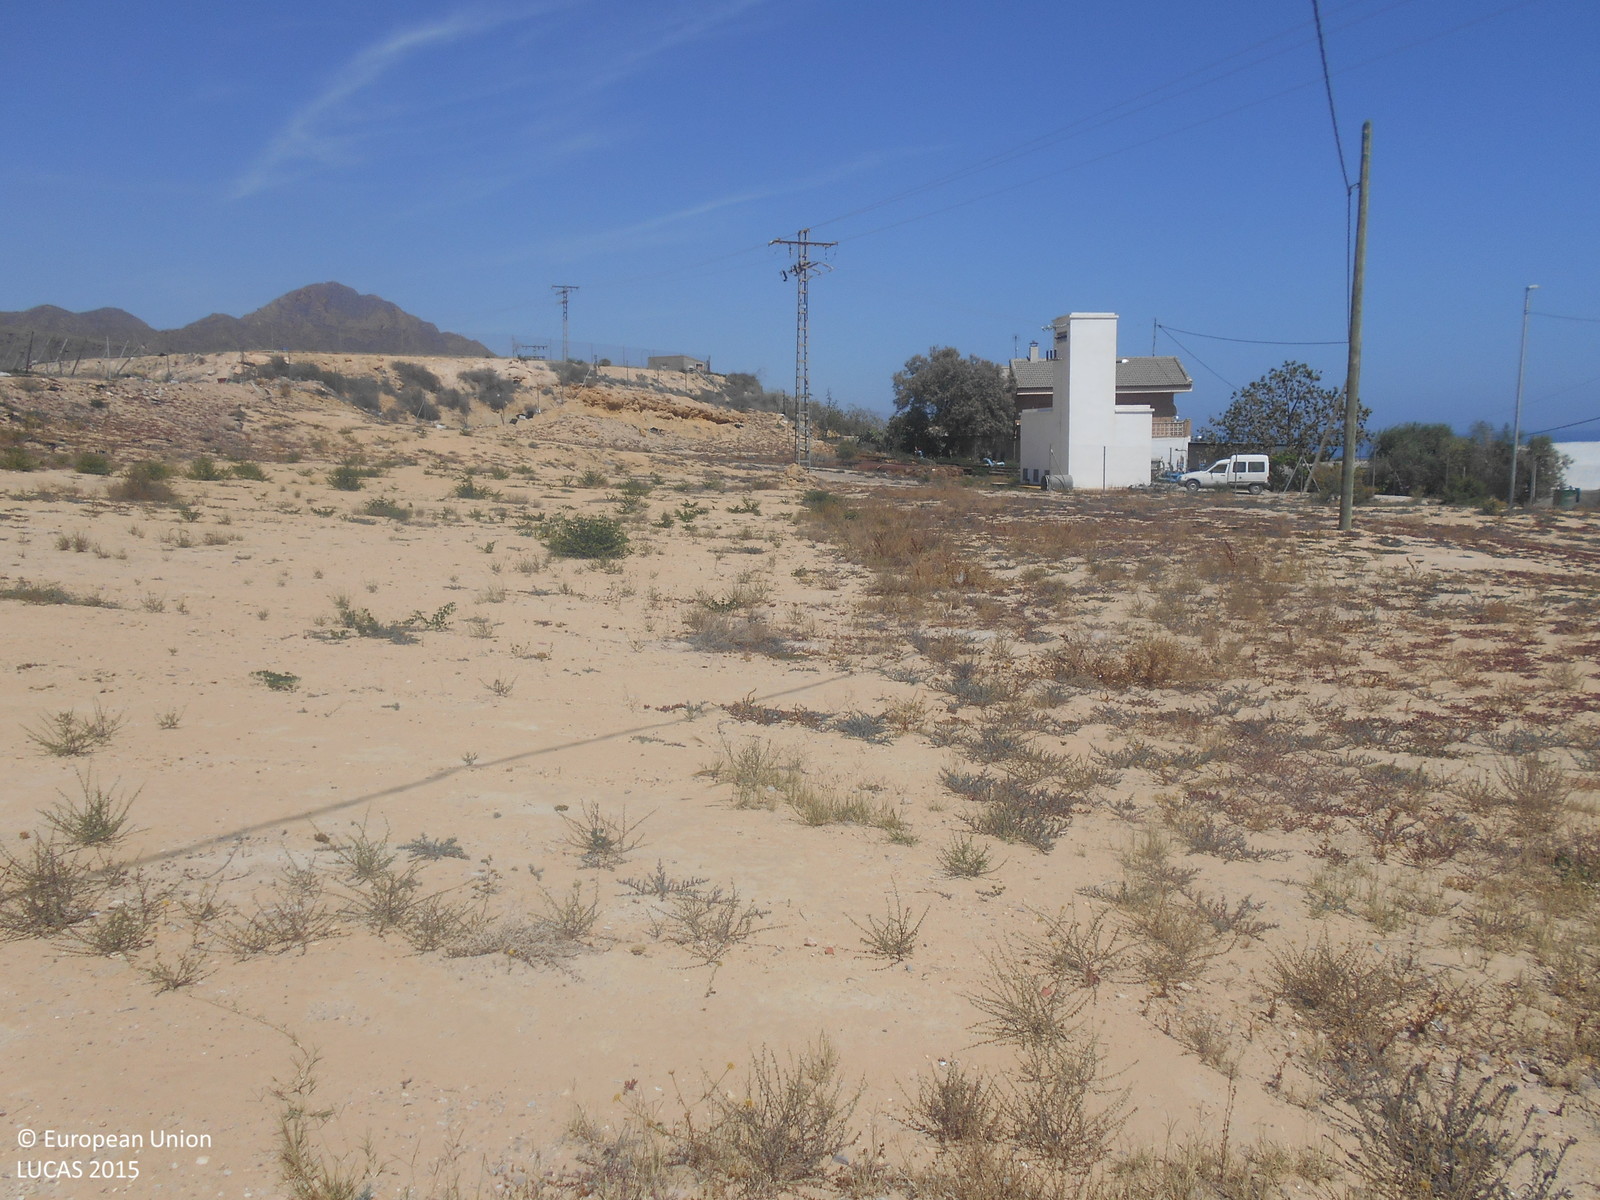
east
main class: Grassland
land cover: Spontaneously vegetated surfaces
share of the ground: 25 - 50 %
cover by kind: unconsolidated bare surface 60 %, herbaceous plants 35 %, shrubs 5 %
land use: Abandoned areas
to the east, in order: Spontaneously vegetated surfaces; Electric lines; Spontaneously vegetated surfaces; Electric lines; Spontaneously vegetated surfaces; Artificial constructions in urban areas; Other fresh vegetables; Other bare soil
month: May
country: ES
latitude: 37.5562
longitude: -1.3788
